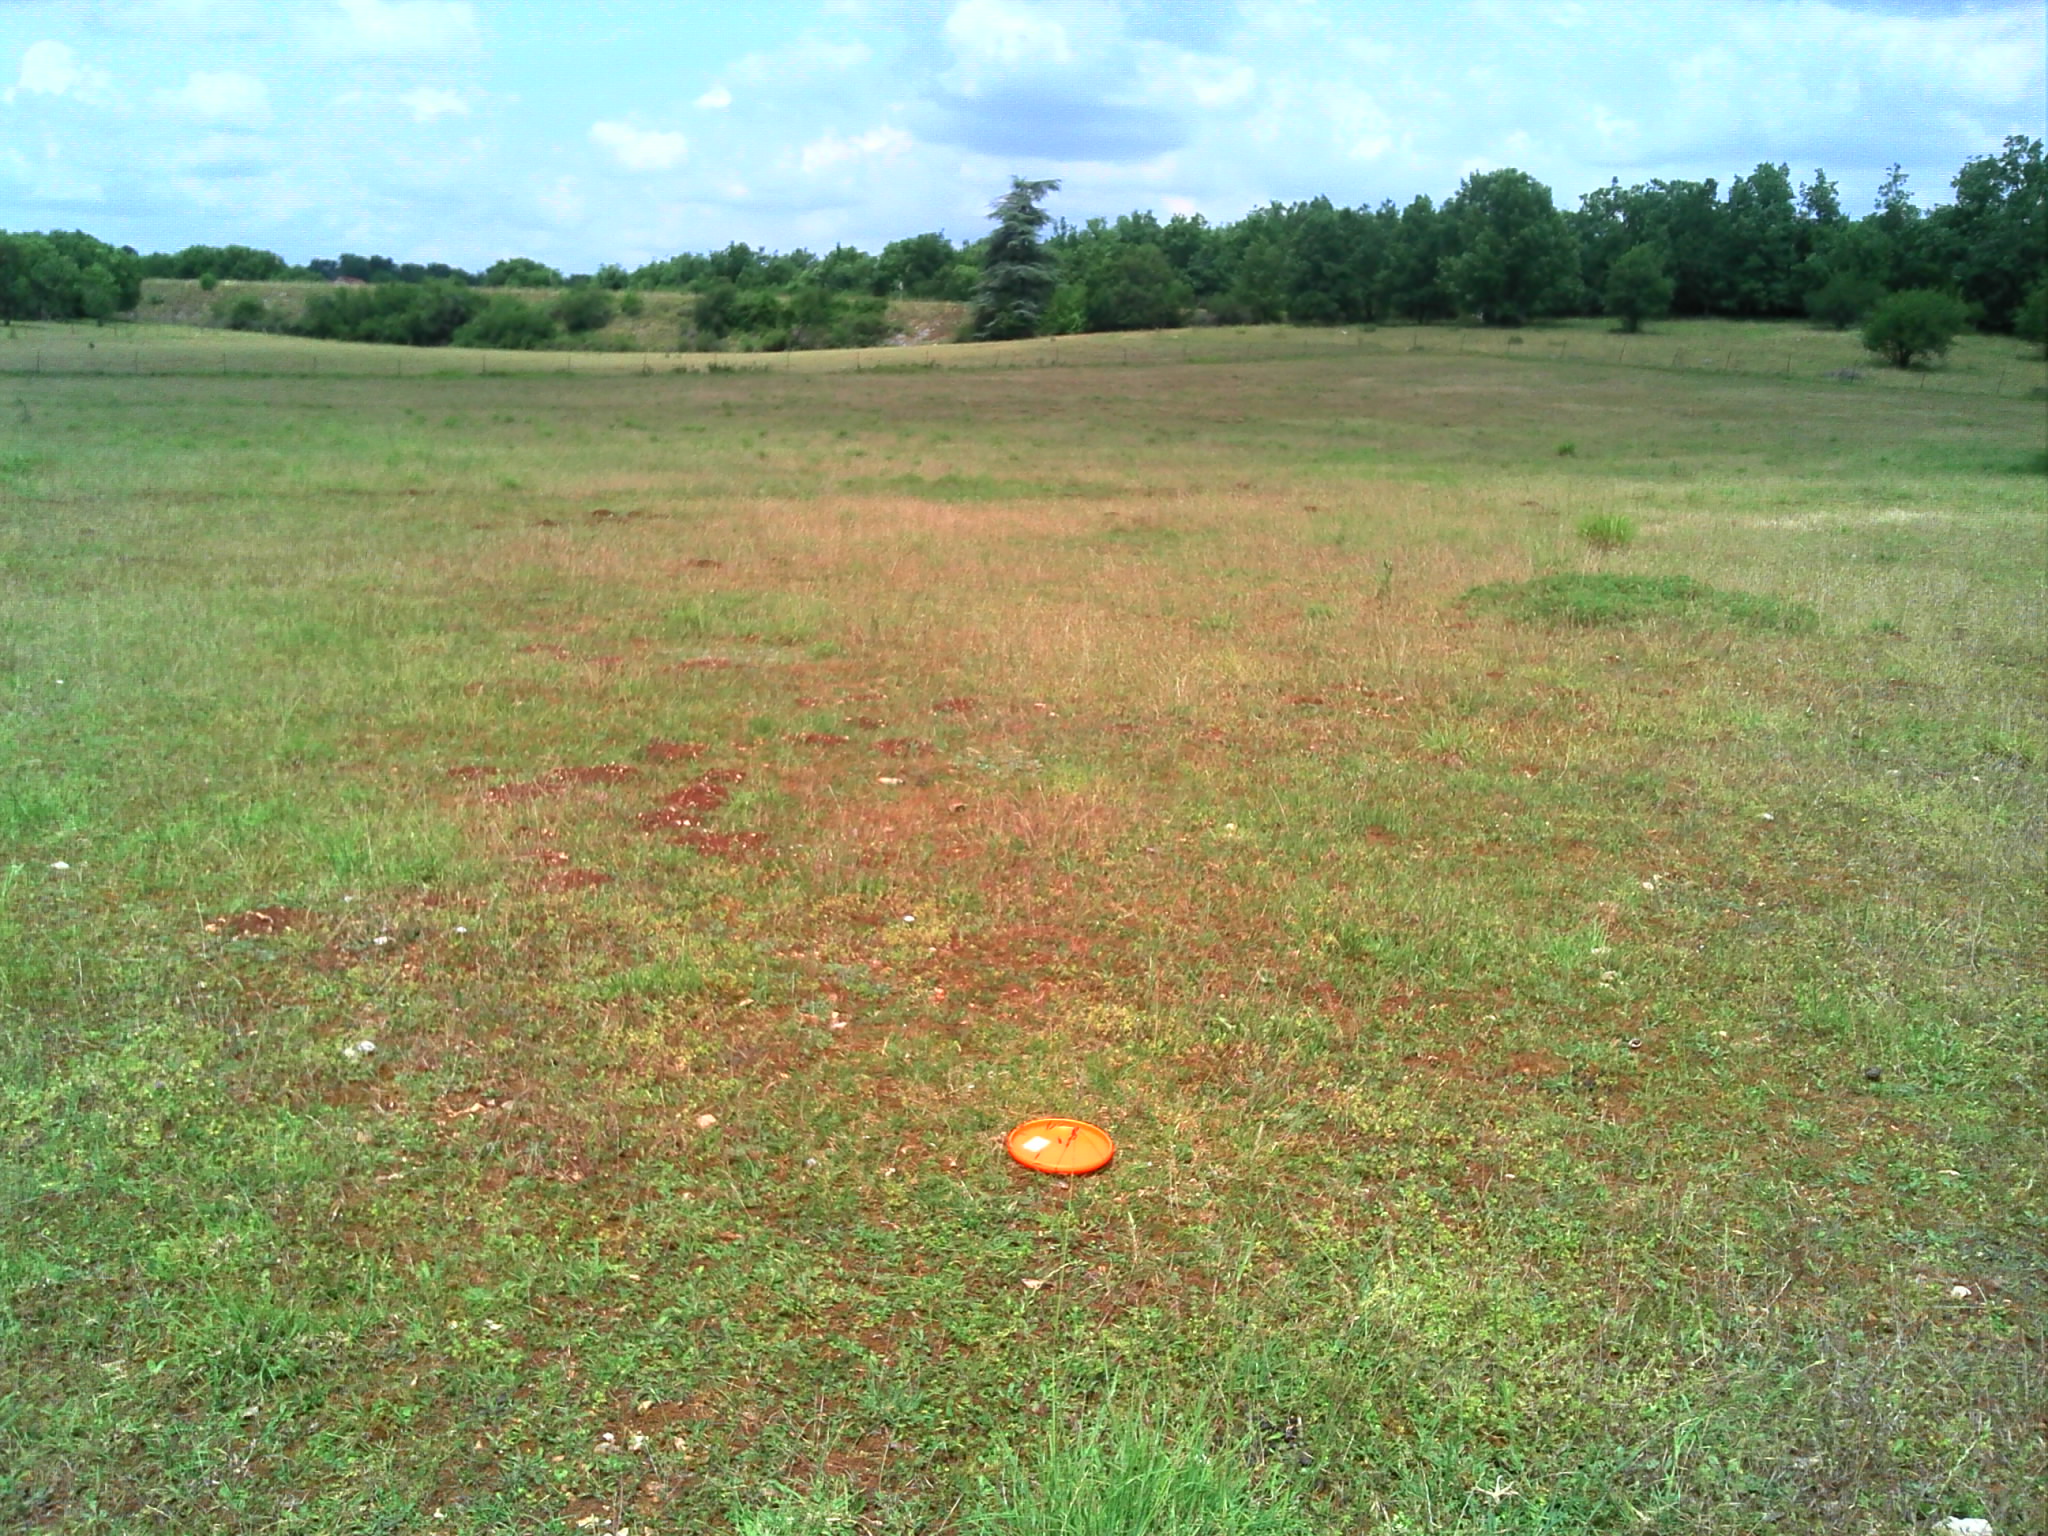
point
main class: Grassland
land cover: Spontaneously vegetated surfaces
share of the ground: > 75 %
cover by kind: herbaceous plants 95 %, shrubs 5 %
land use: Agriculture (excluding fallow land and kitchen gardens)
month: June
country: FR
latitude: 44.6052
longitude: 1.7968
